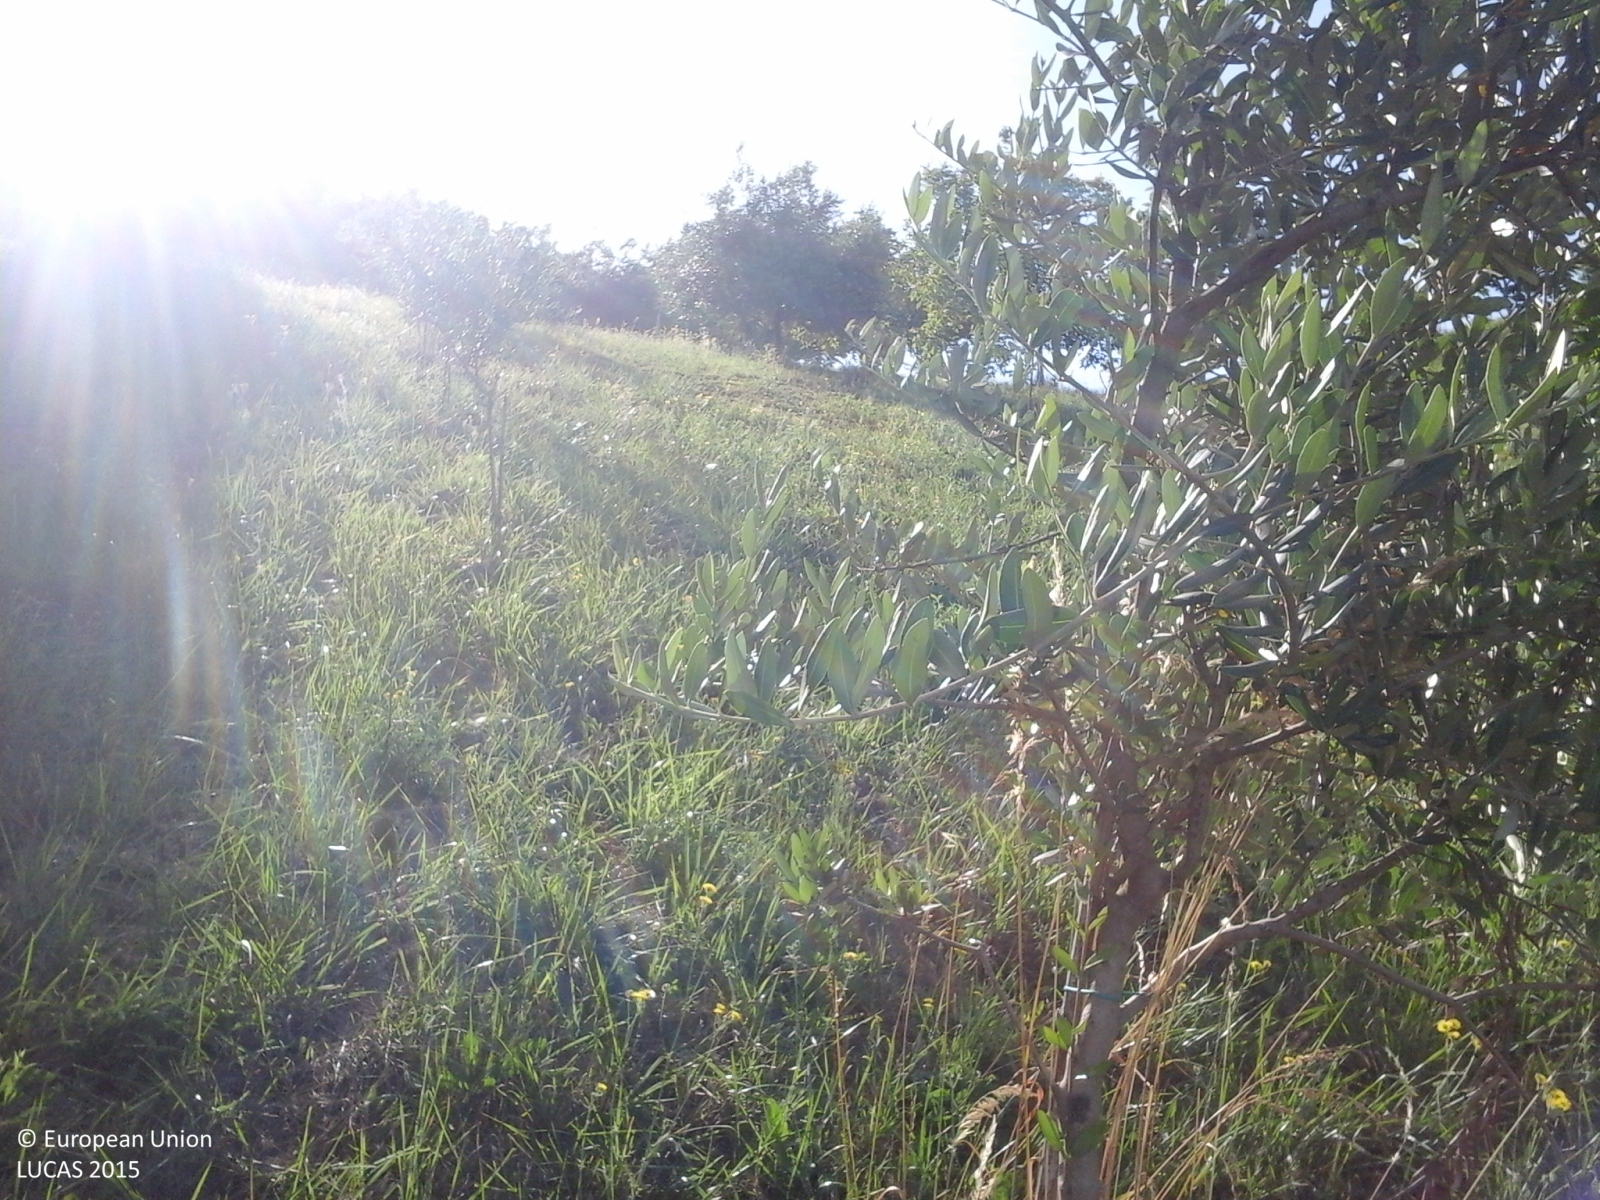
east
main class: Grassland
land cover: Grassland with sparse tree/shrub cover
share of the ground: > 75 %
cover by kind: herbaceous plants 95 %, broadleaved forest trees 5 %
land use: Agriculture (excluding fallow land and kitchen gardens)
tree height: > 5 m
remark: Clear cut
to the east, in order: Grassland with sparse tree/shrub cover; Olive groves; Artificial constructions in urban areas; Electric lines; Olive groves; Other fruit trees and berries; Broadleaved woodland
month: June
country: IT
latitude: 44.6205
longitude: 10.3395
